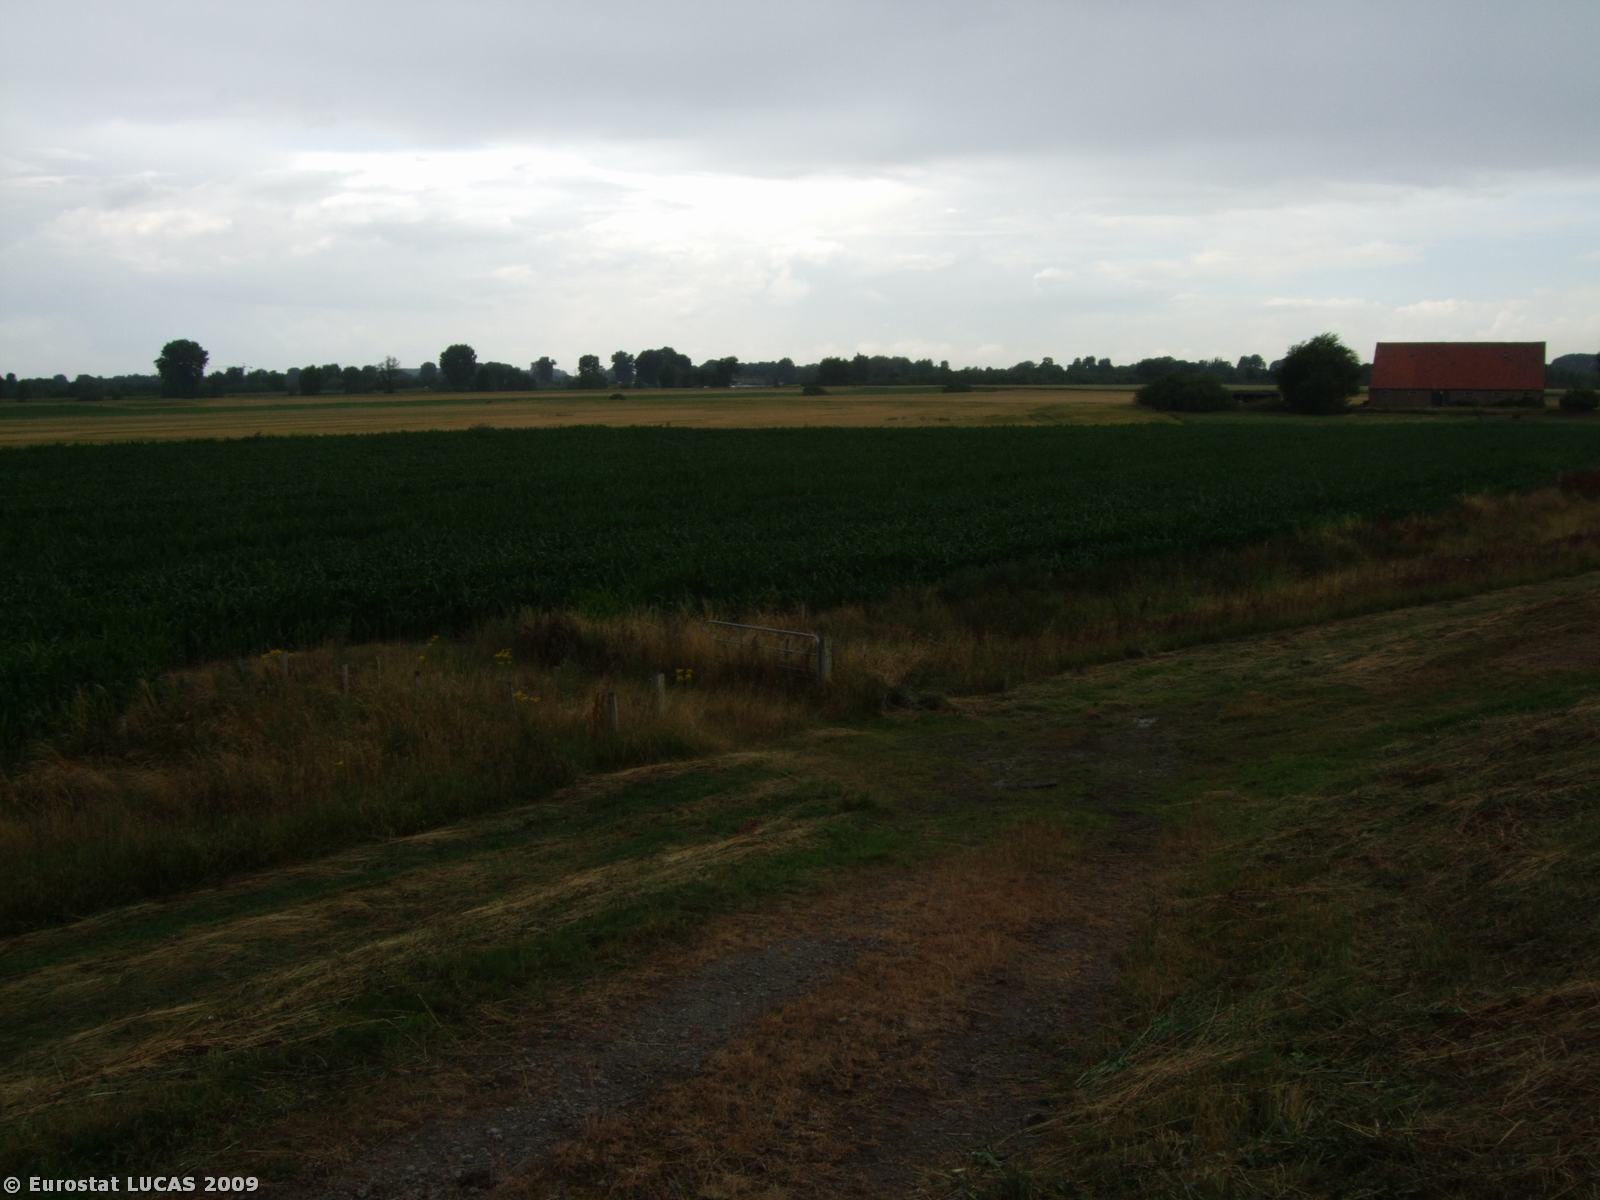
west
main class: Cropland
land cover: Maize
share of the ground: > 75 %
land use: Agriculture (excluding fallow land and kitchen gardens)
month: July
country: NL
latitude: 51.8214
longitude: 5.4281
